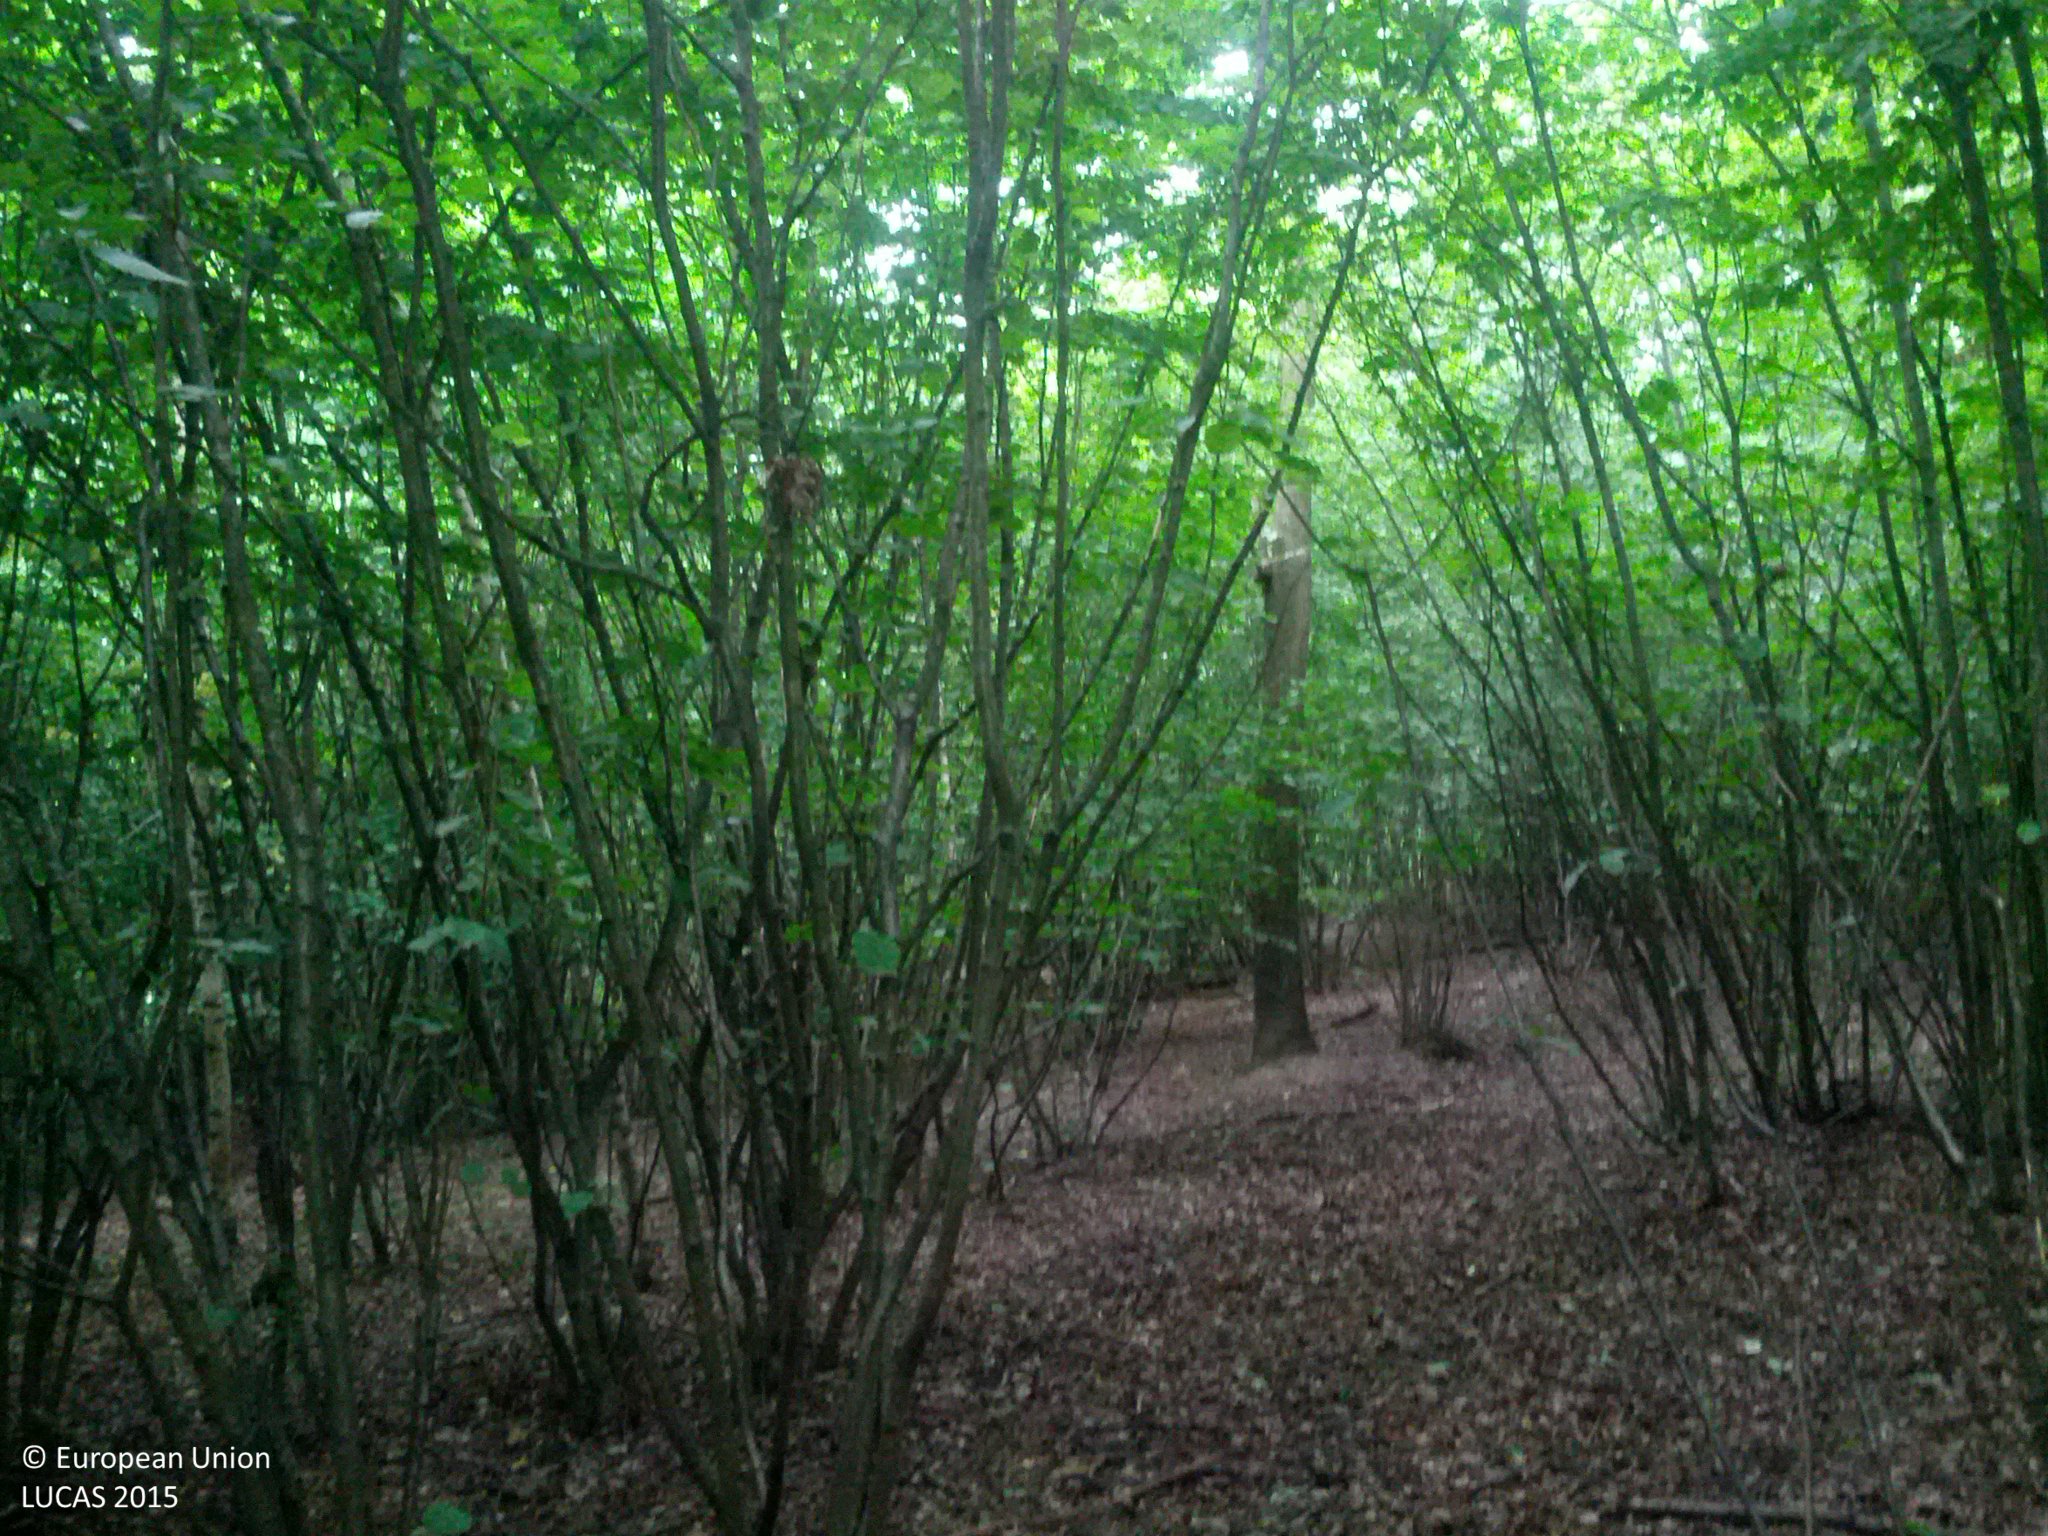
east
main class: Woodland
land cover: Broadleaved woodland
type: thermophilous deciduous forest
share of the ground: > 75 %
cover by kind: broadleaved forest trees 95 %, unconsolidated bare surface 5 %
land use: Forestry
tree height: > 5 m
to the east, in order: Broadleaved woodland; Fences; Broadleaved woodland; Fences; Grass margins; Tracks; Broadleaved woodland
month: July
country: AT
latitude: 48.5560
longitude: 16.1695
